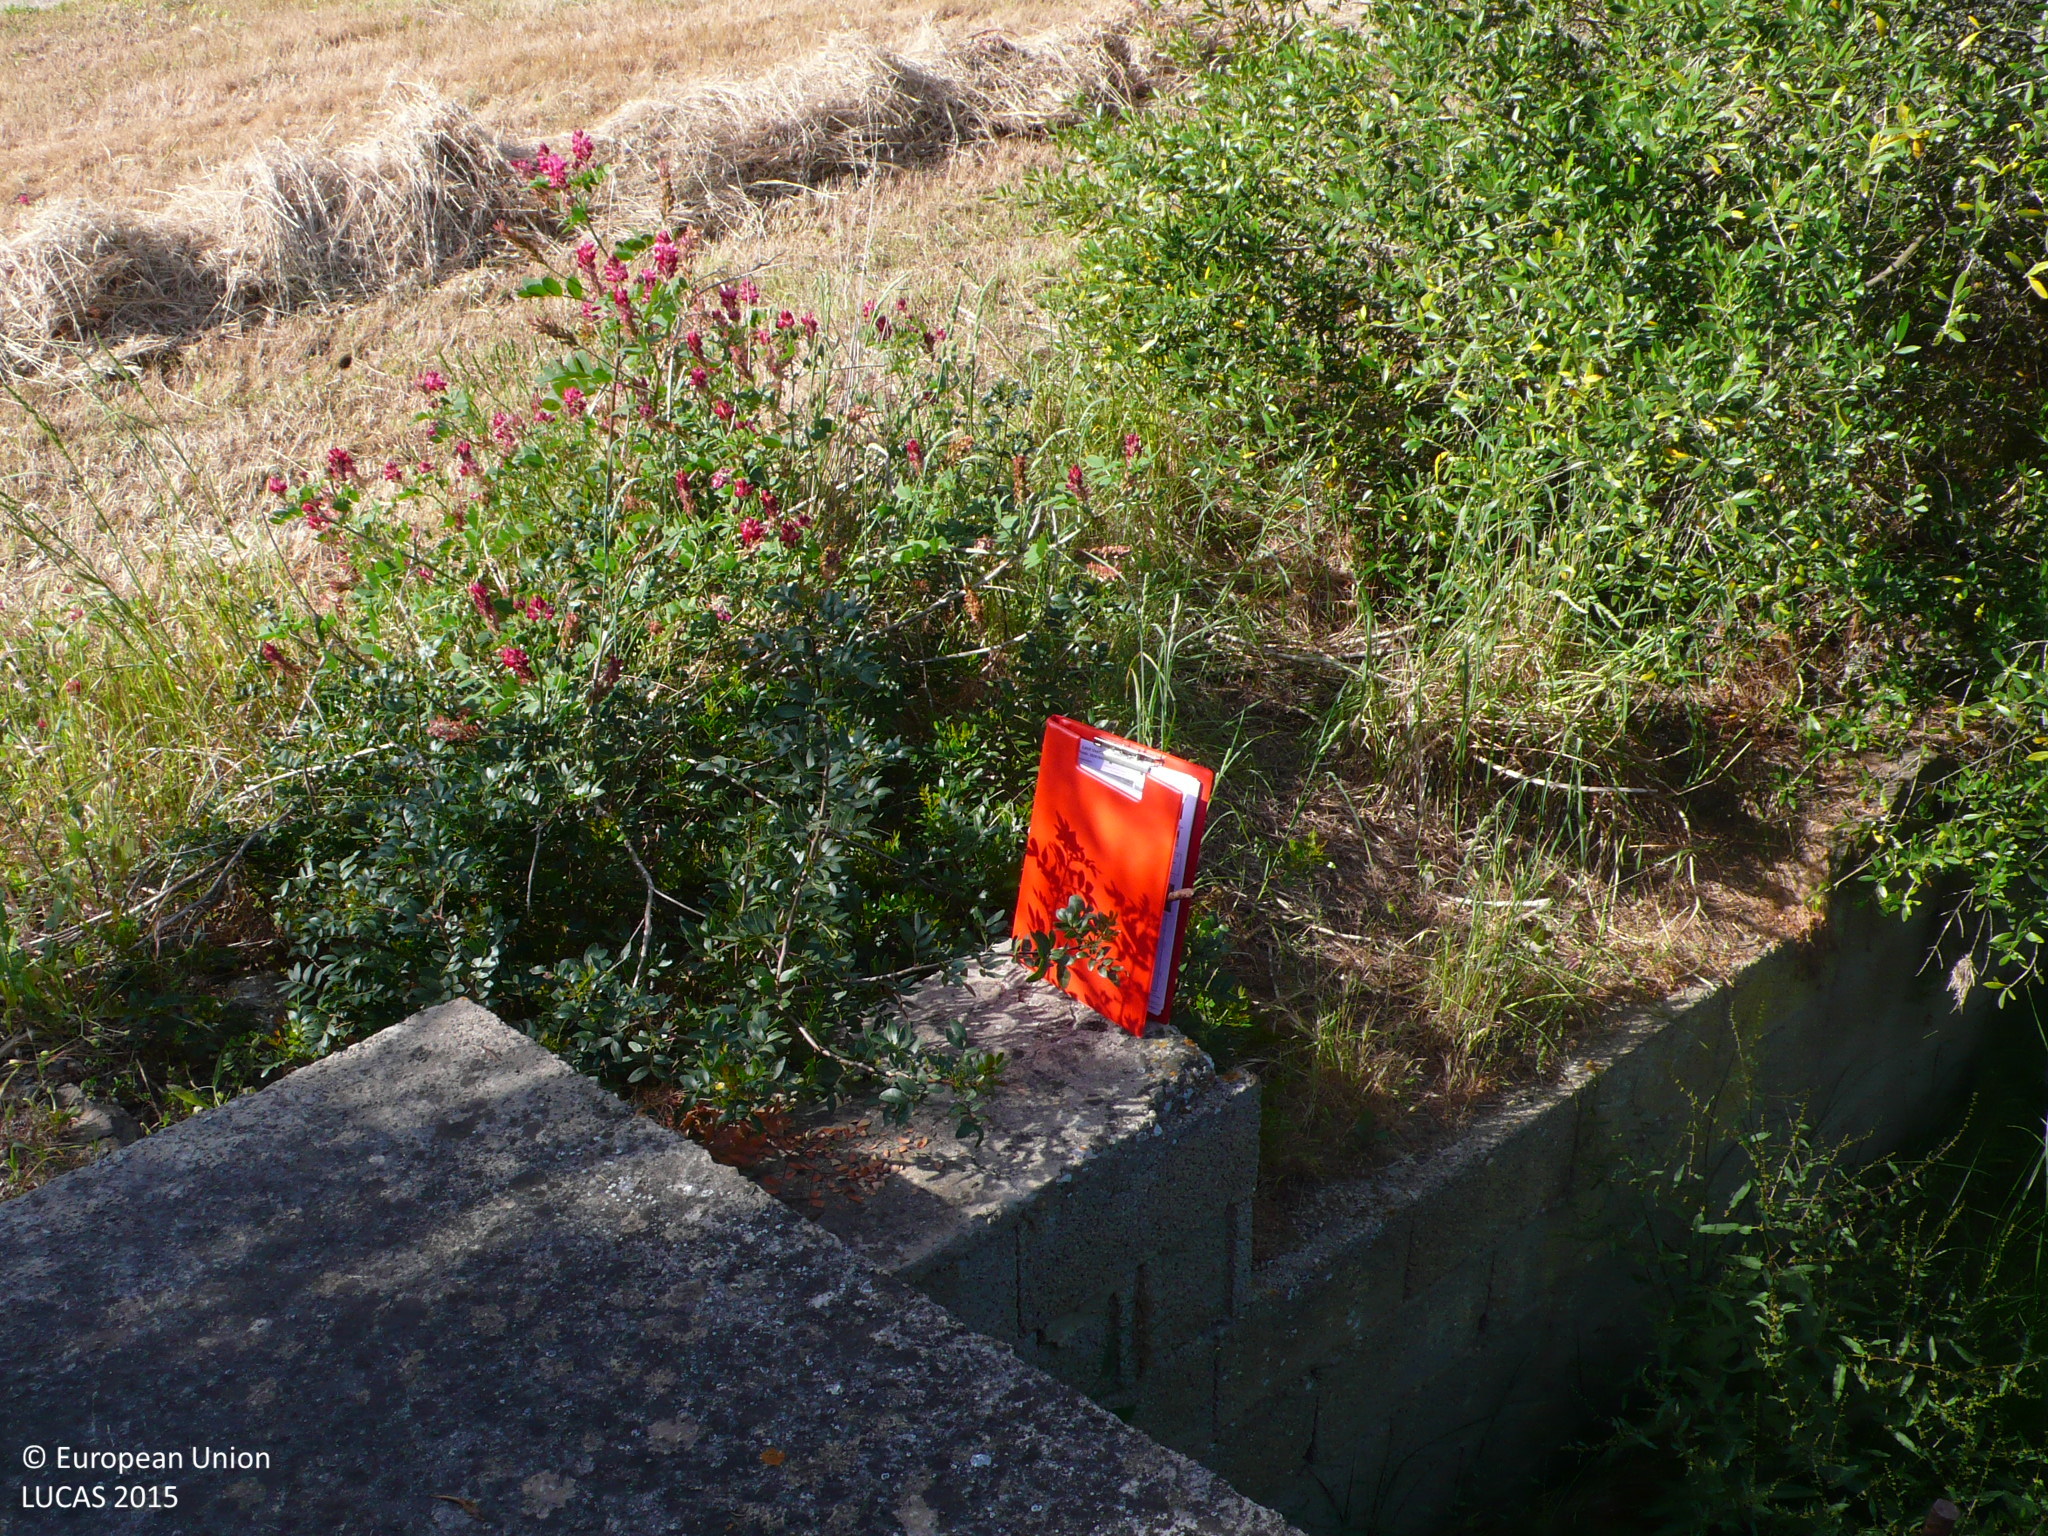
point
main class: Cropland
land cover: Mixed cereals for fodder
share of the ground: < 10 %
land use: Agriculture (excluding fallow land and kitchen gardens)
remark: Harvested field
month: May
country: ES
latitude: 39.9357
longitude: 4.2566
